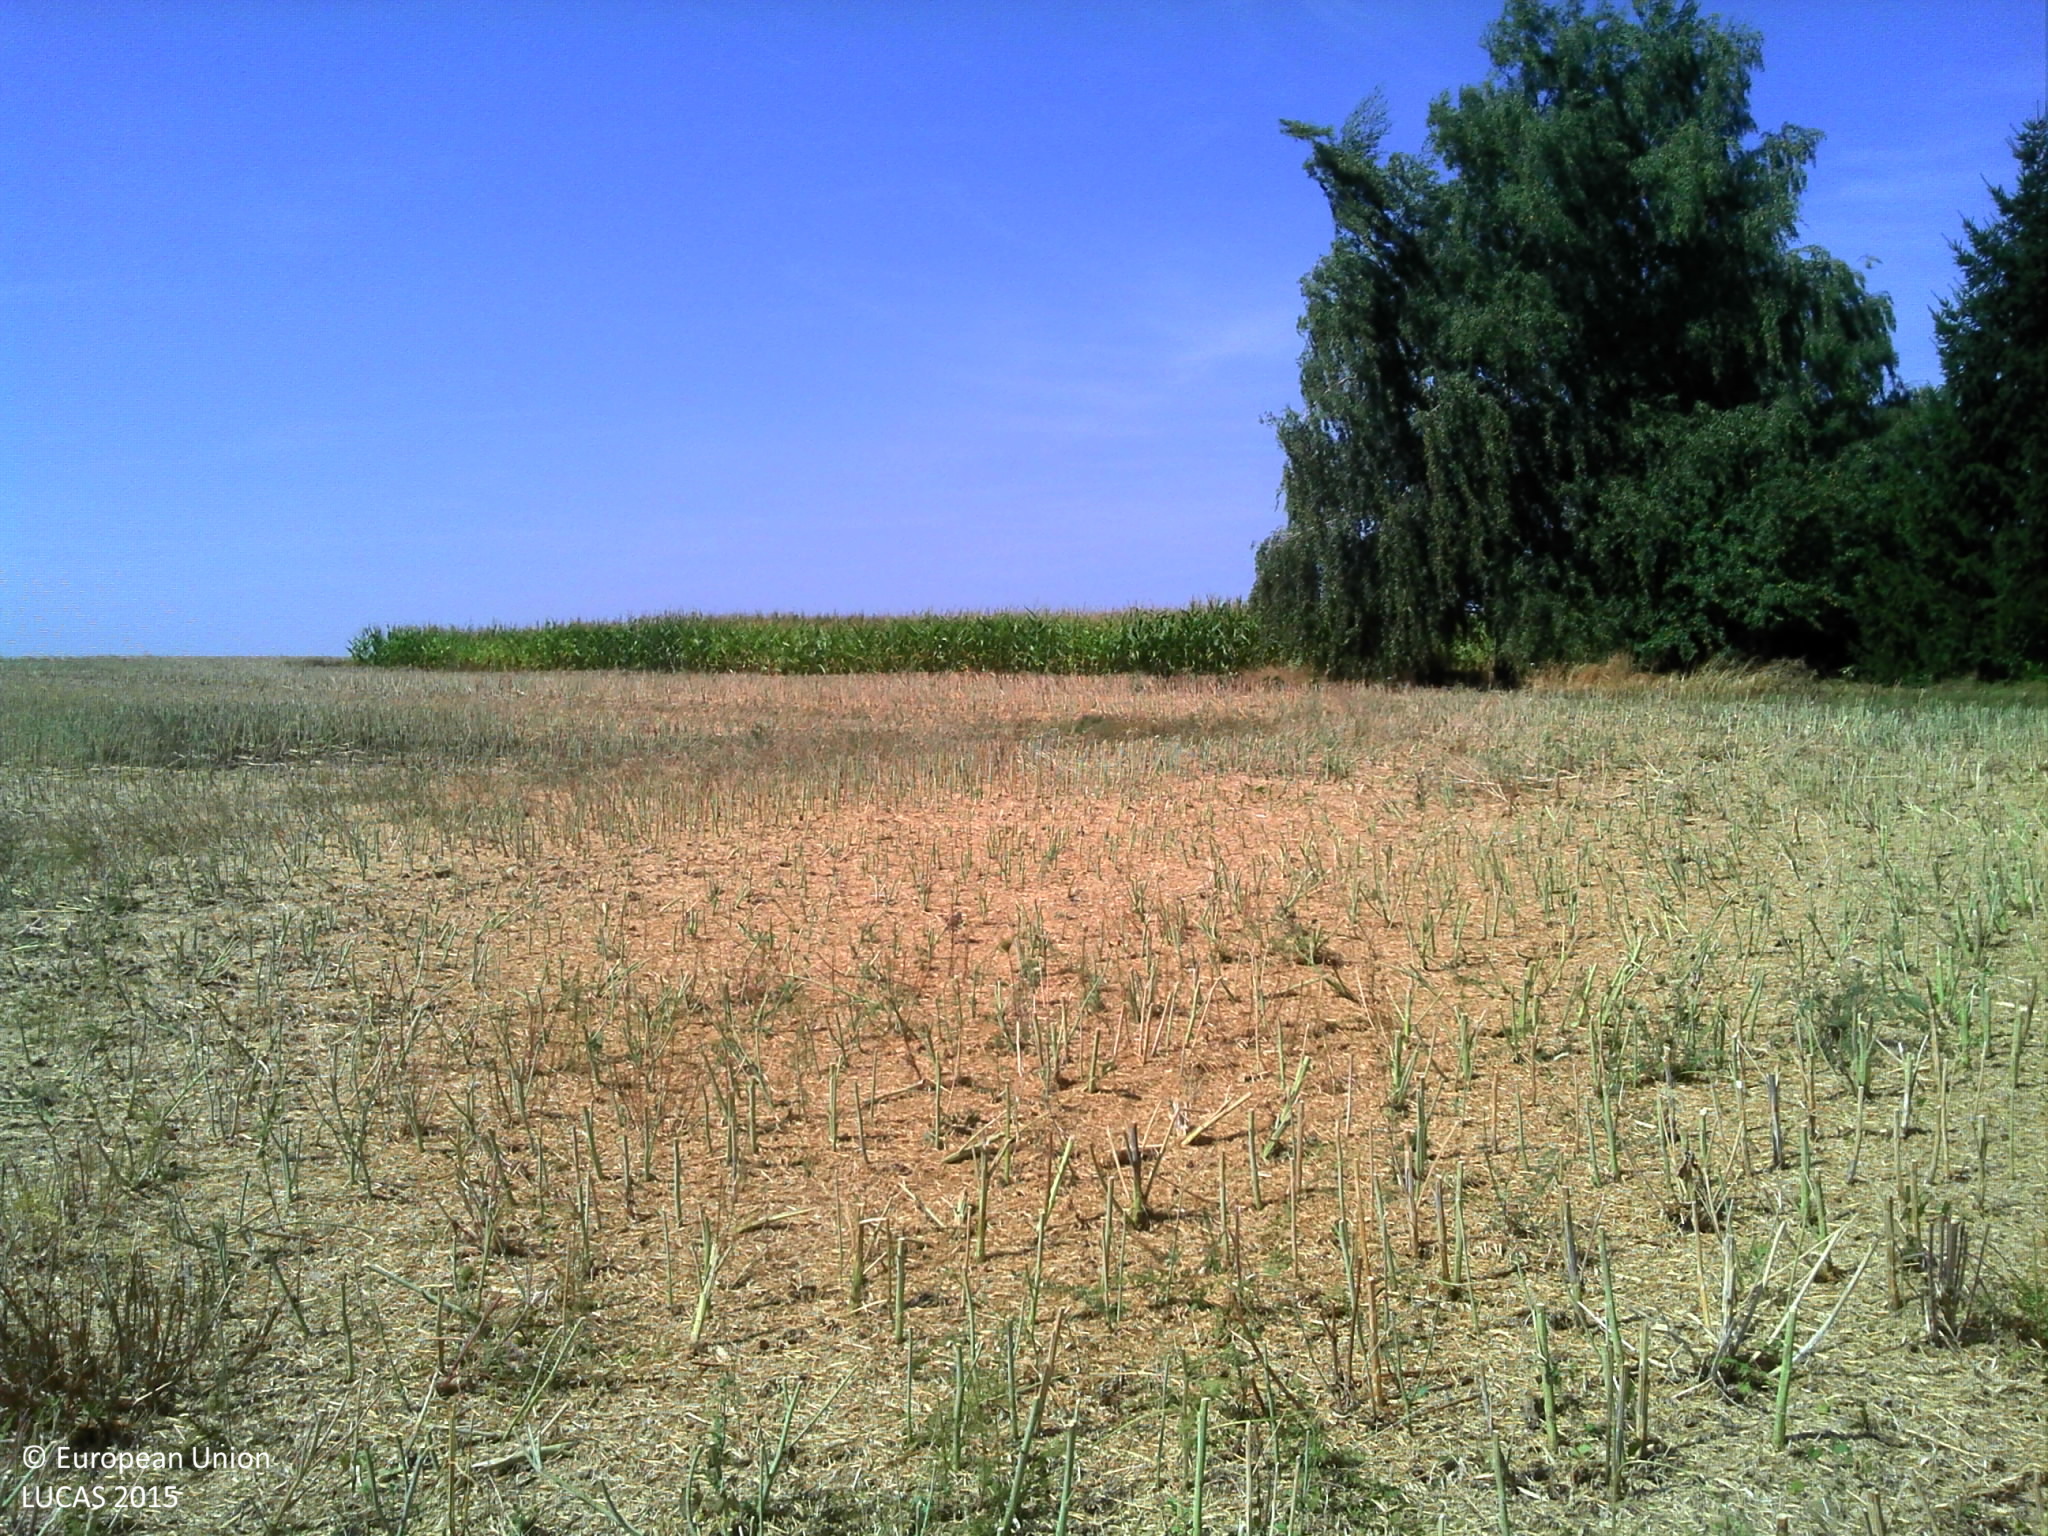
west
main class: Grassland
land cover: Grassland with sparse tree/shrub cover
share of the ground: > 75 %
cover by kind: herbaceous plants 85 %, broadleaved forest trees 5 %, consolidated bare surface 5 %
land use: Residential
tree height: < 5 m
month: August
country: FR
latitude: 48.8502
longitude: 3.3013
